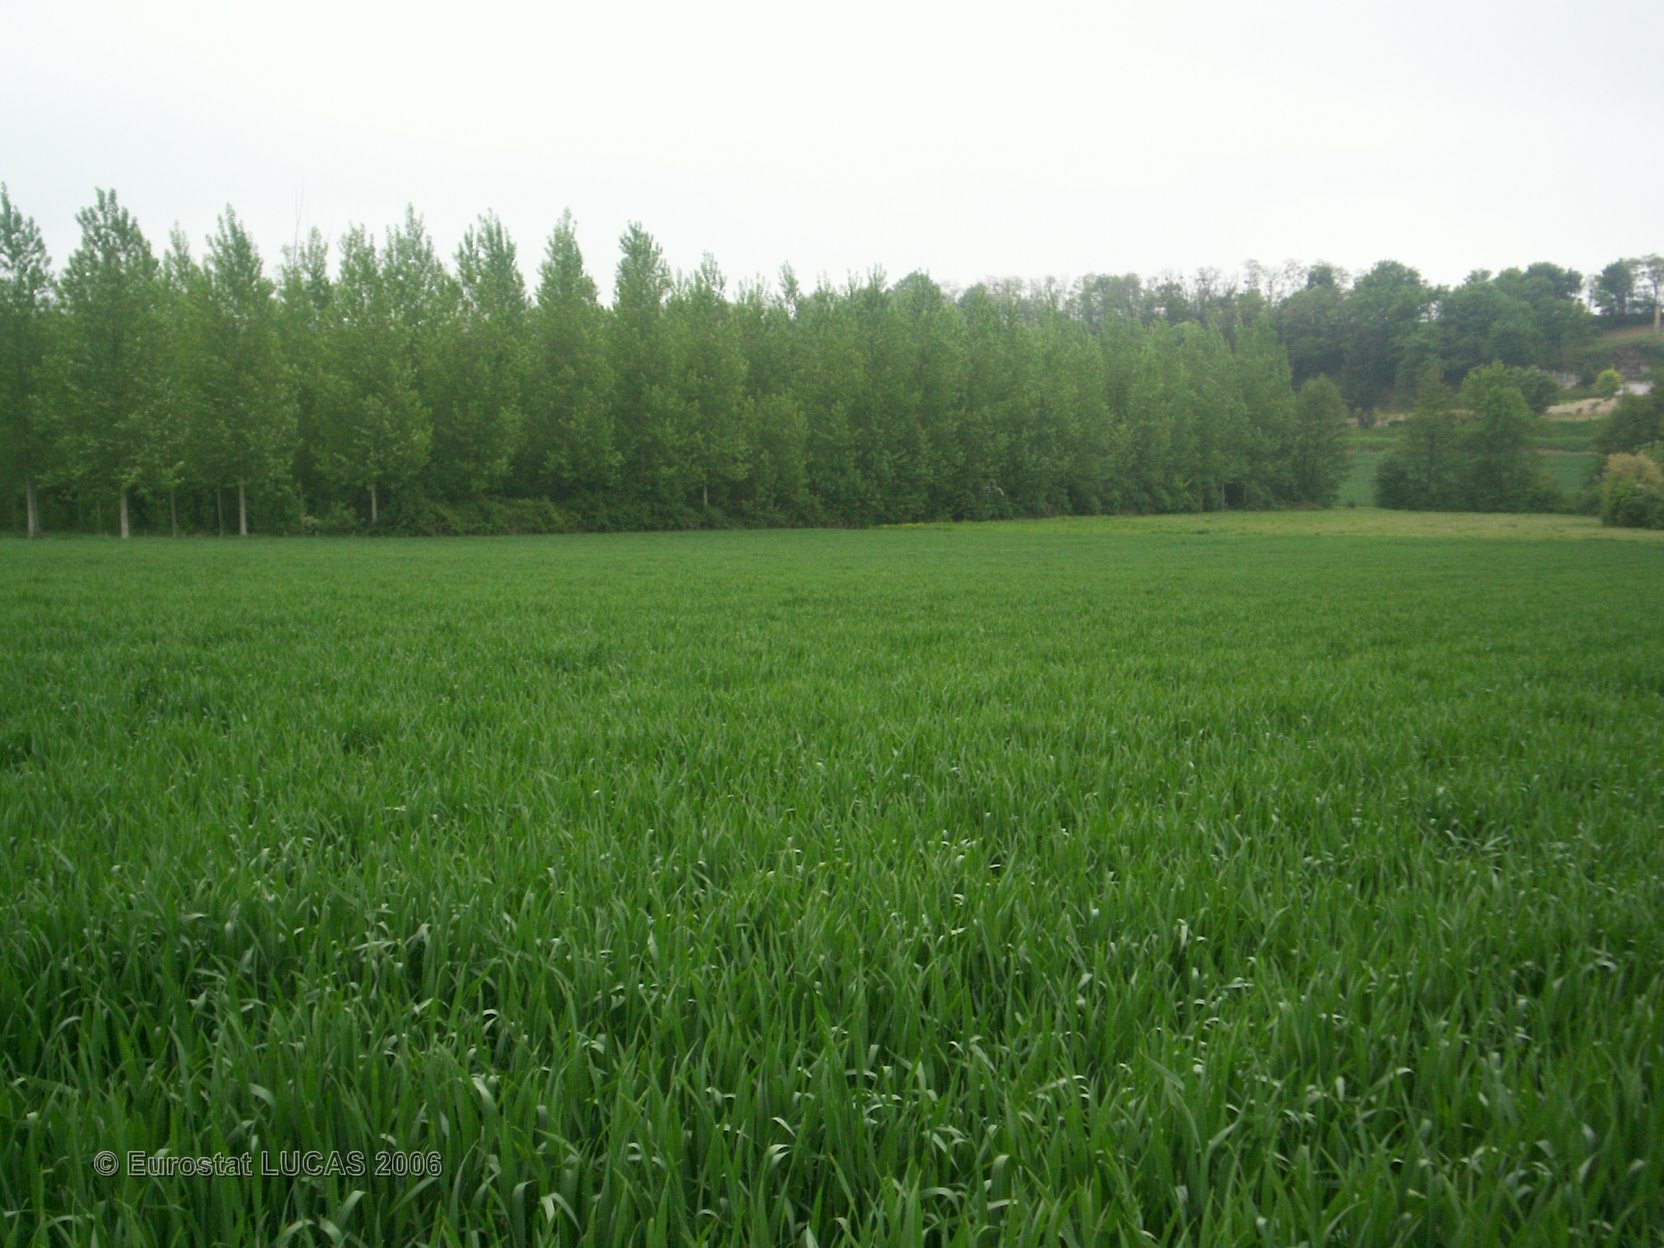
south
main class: Cropland
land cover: Common wheat
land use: Agriculture (excluding fallow land and kitchen gardens)
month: May
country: FR
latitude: 47.6660
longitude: 0.4827
